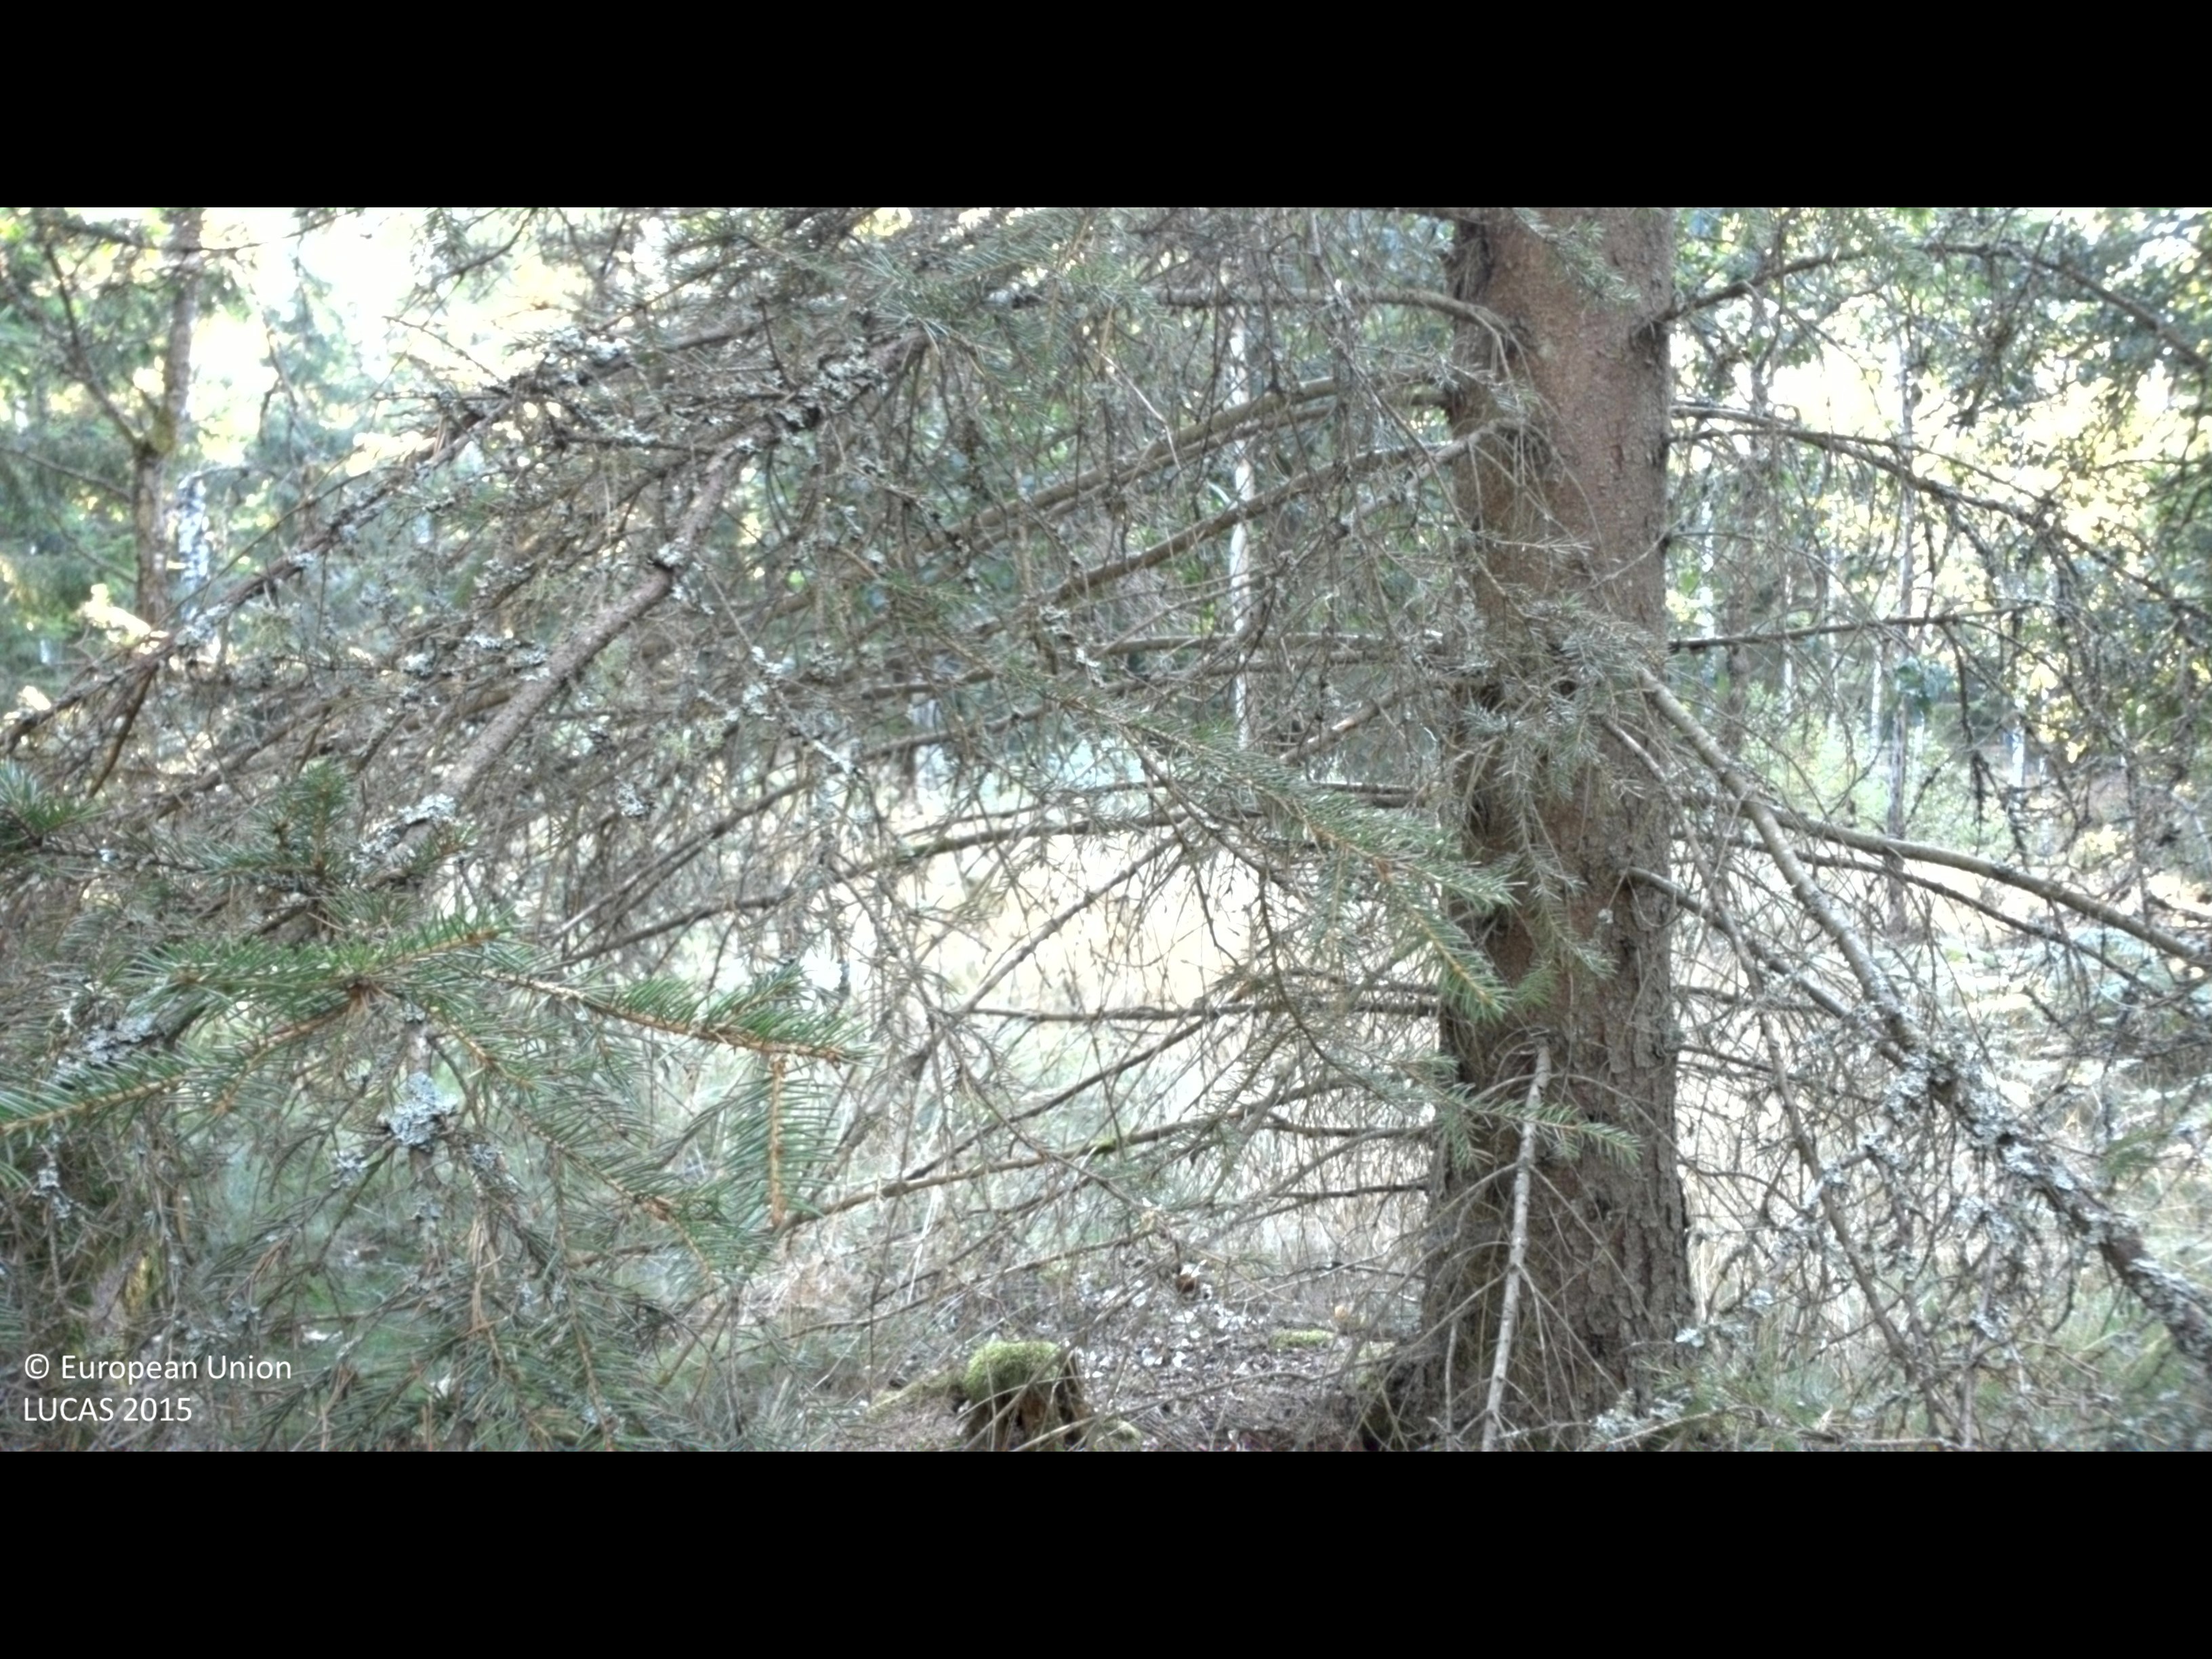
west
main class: Woodland
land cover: Spruce dominated coniferous woodland
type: boreal forest
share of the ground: 50 - 75 %
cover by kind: coniferous forest trees 55 %, herbaceous plants 20 %, lichens and mosses 20 %, broadleaved forest trees 5 %
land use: Forestry
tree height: > 5 m
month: August
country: SE
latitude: 56.2442
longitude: 15.2111
